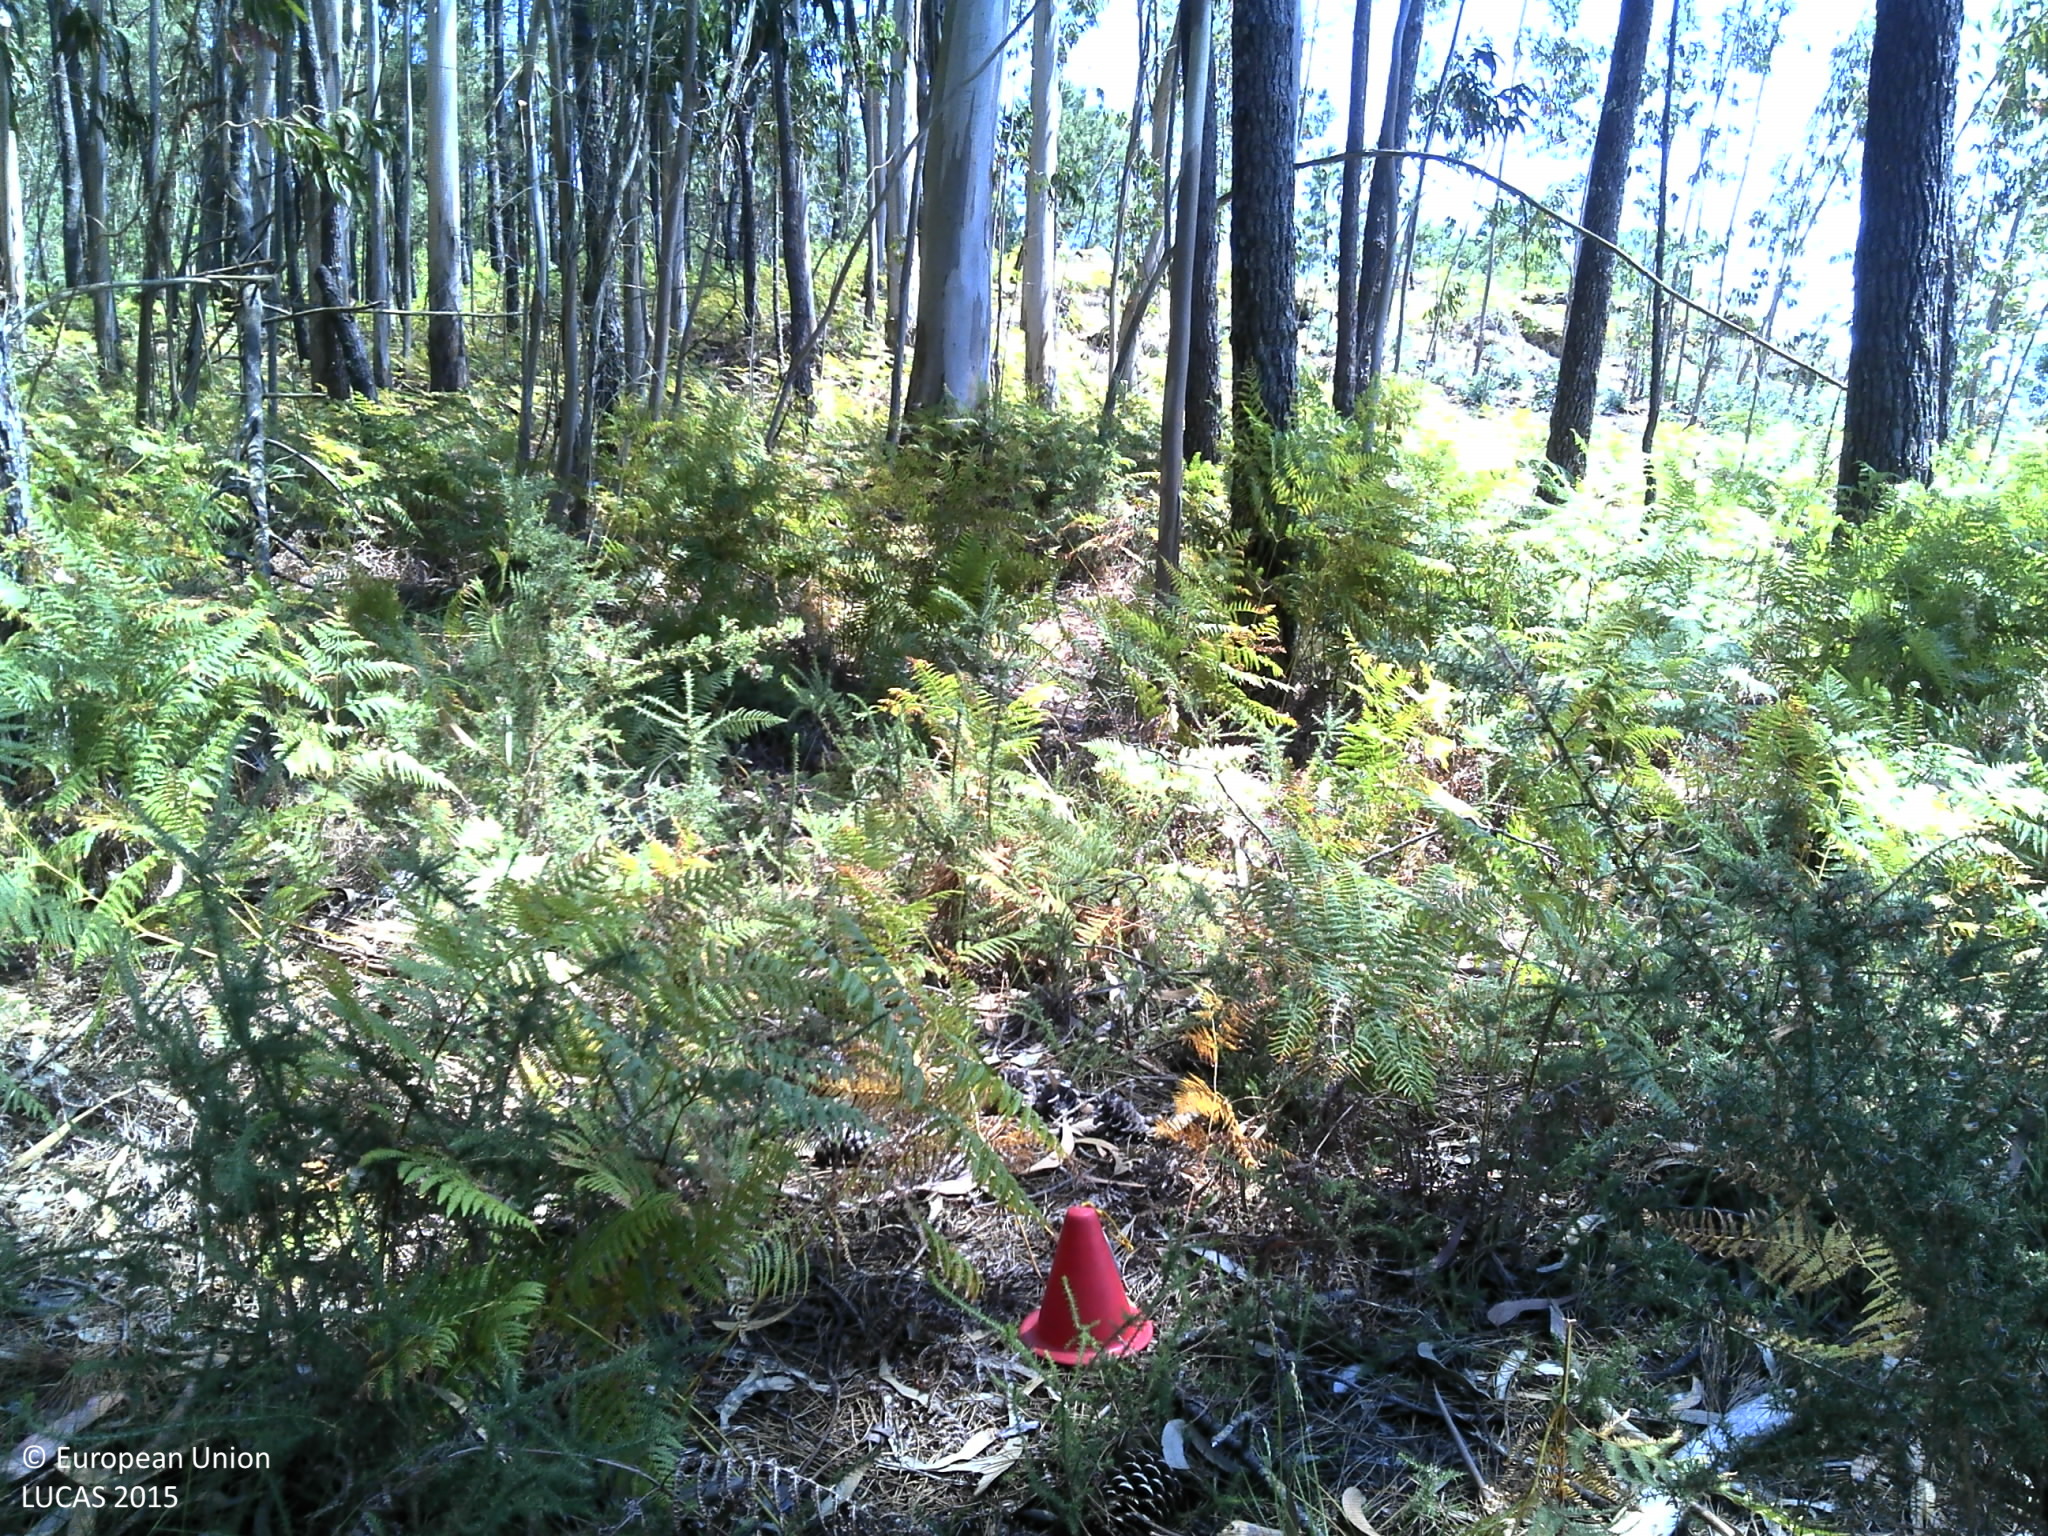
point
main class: Woodland
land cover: Pine dominated mixed woodland
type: coniferous forest of the mediterranean region
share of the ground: 50 - 75 %
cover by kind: coniferous forest trees 75 %, broadleaved forest trees 25 %
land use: Forestry
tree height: > 5 m
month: May
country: PT
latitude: 41.7935
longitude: -8.6363
